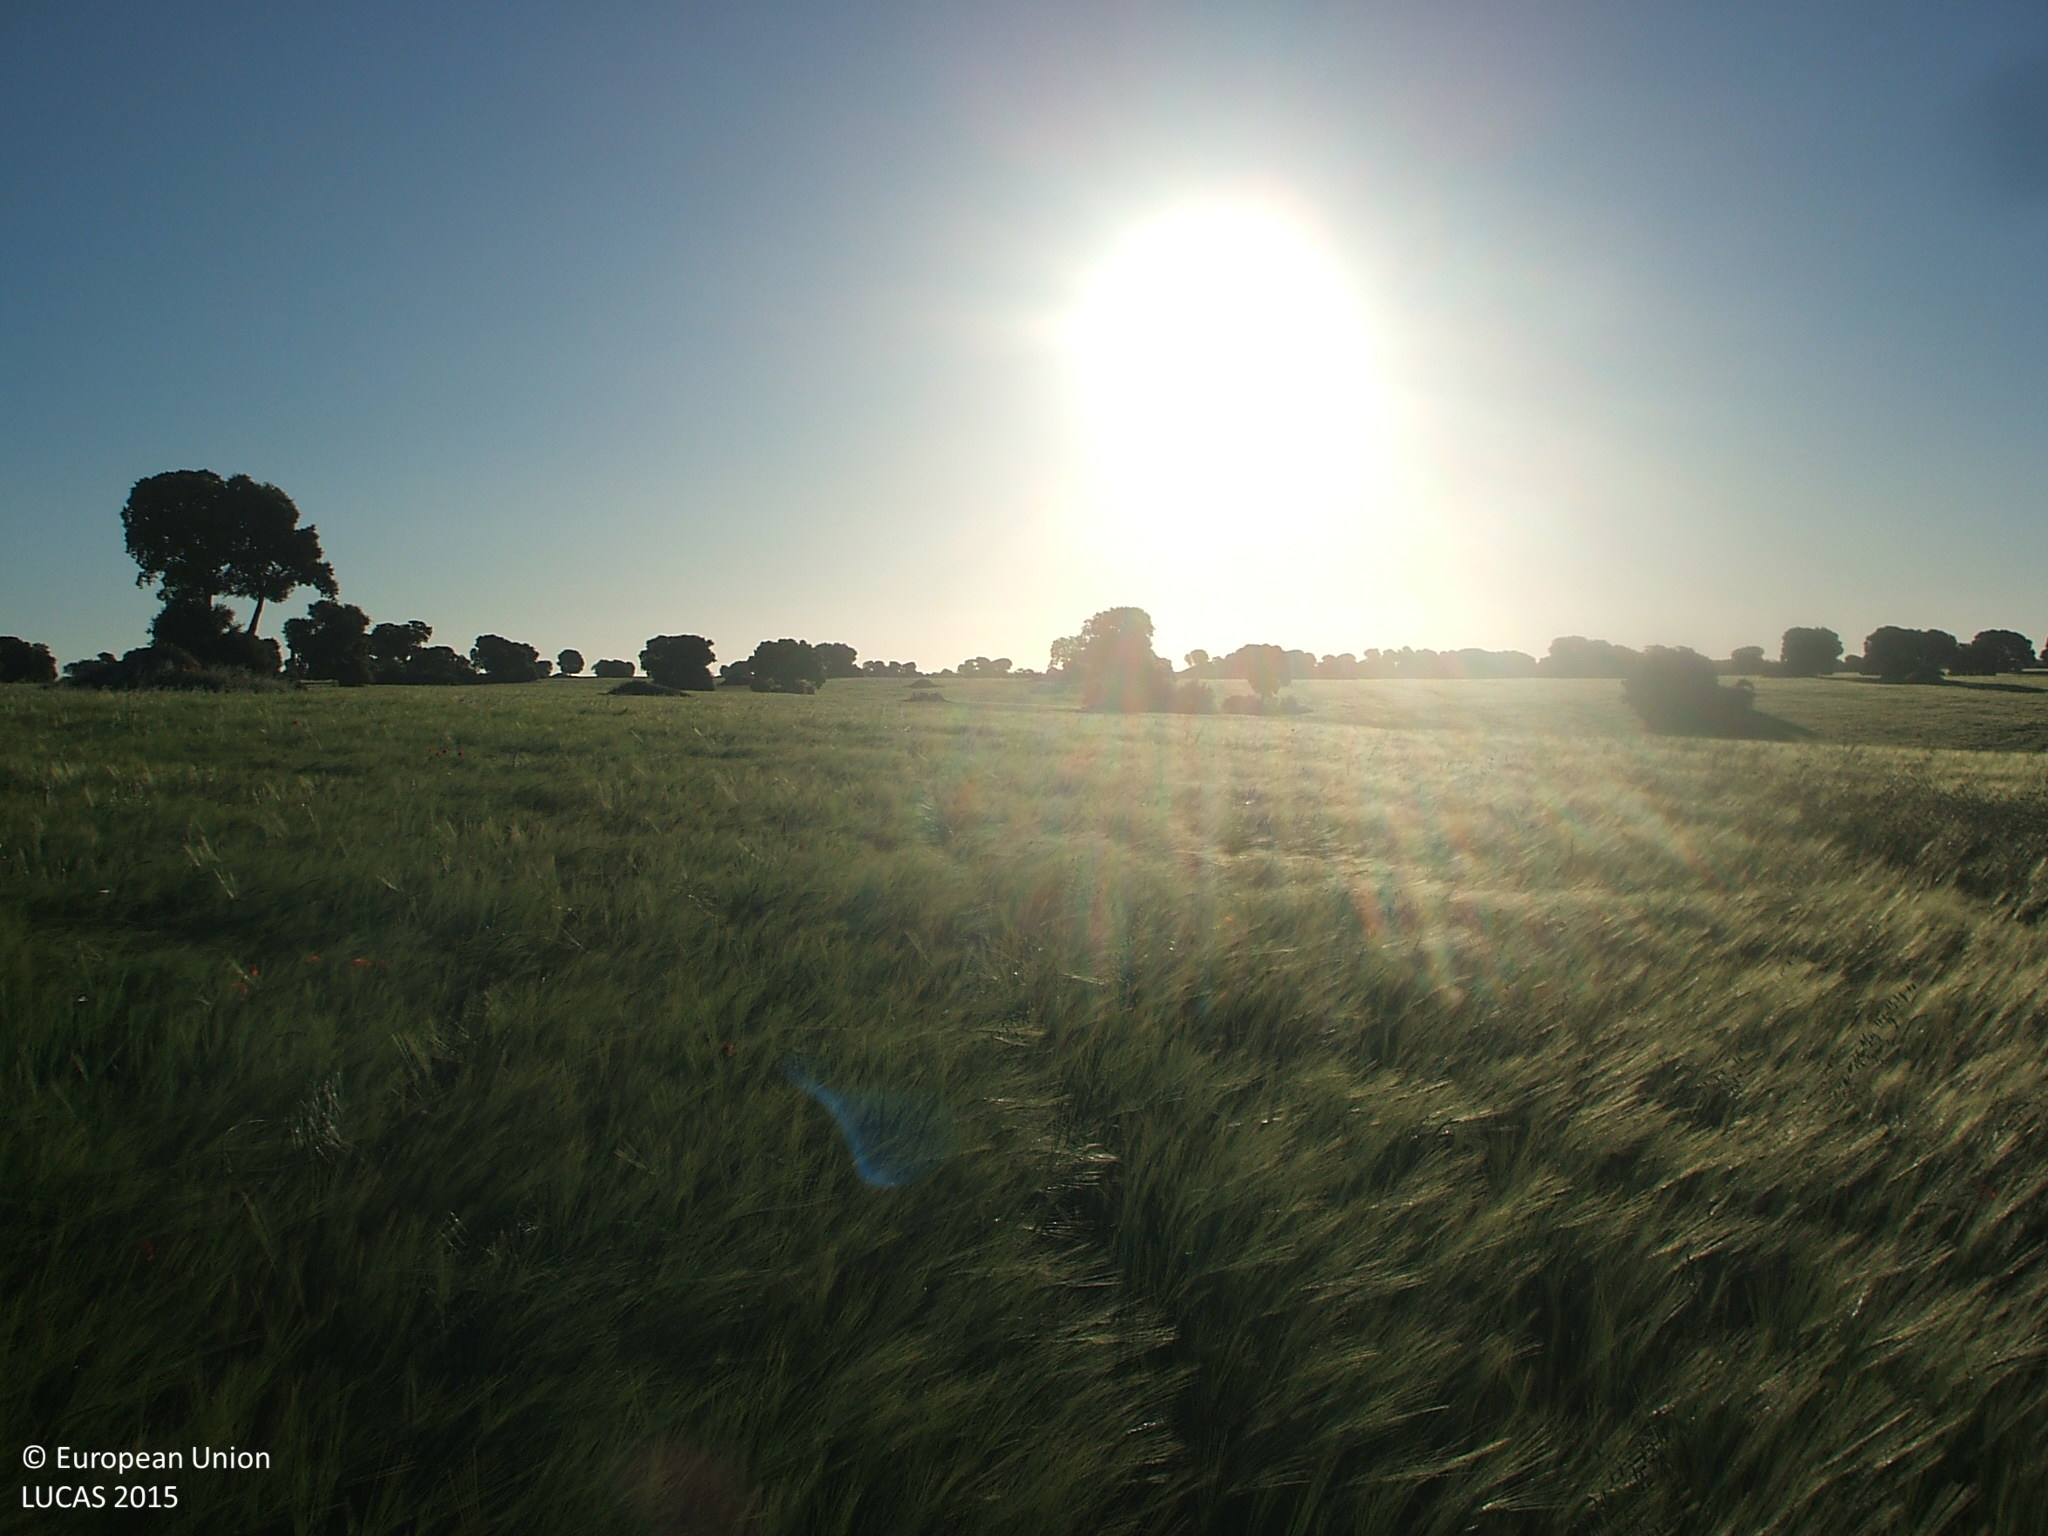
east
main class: Cropland
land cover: Barley
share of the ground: > 75 %
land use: Agriculture (excluding fallow land and kitchen gardens)
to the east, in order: Barley
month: May
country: ES
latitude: 40.6605
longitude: -2.8636
